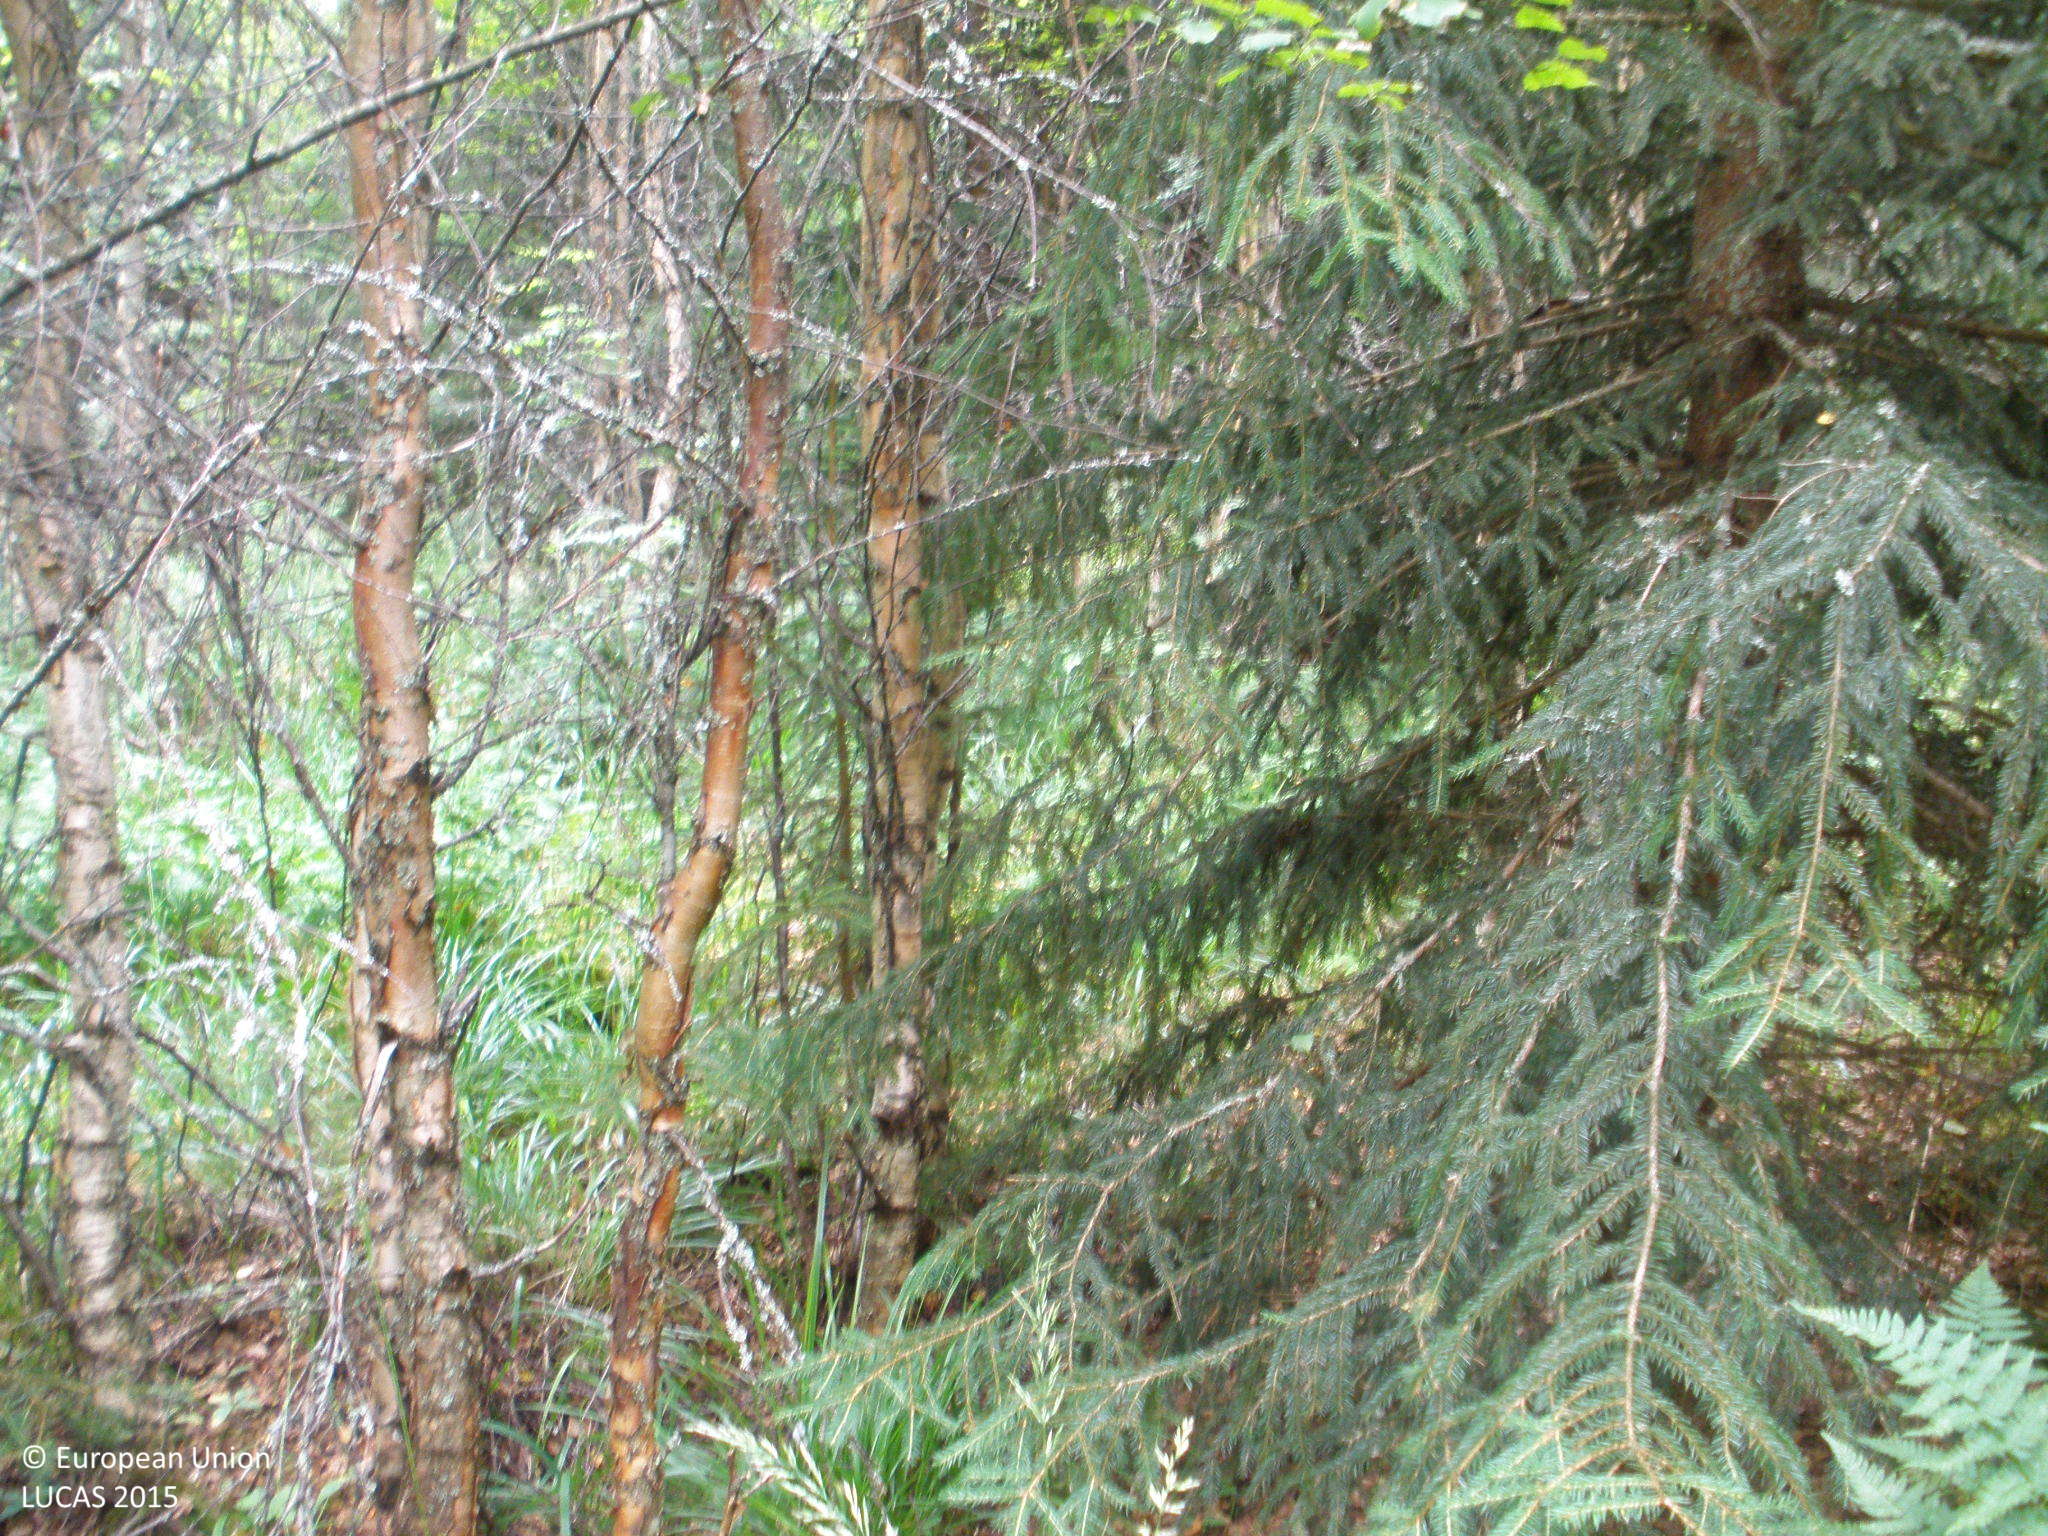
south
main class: Woodland
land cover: Spruce dominated mixed woodland
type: boreal forest
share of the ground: > 75 %
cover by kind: broadleaved forest trees 45 %, coniferous forest trees 30 %, herbaceous plants 15 %, shrubs 10 %
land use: Forestry
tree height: > 5 m
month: July
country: FI
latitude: 61.1479
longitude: 25.0686
